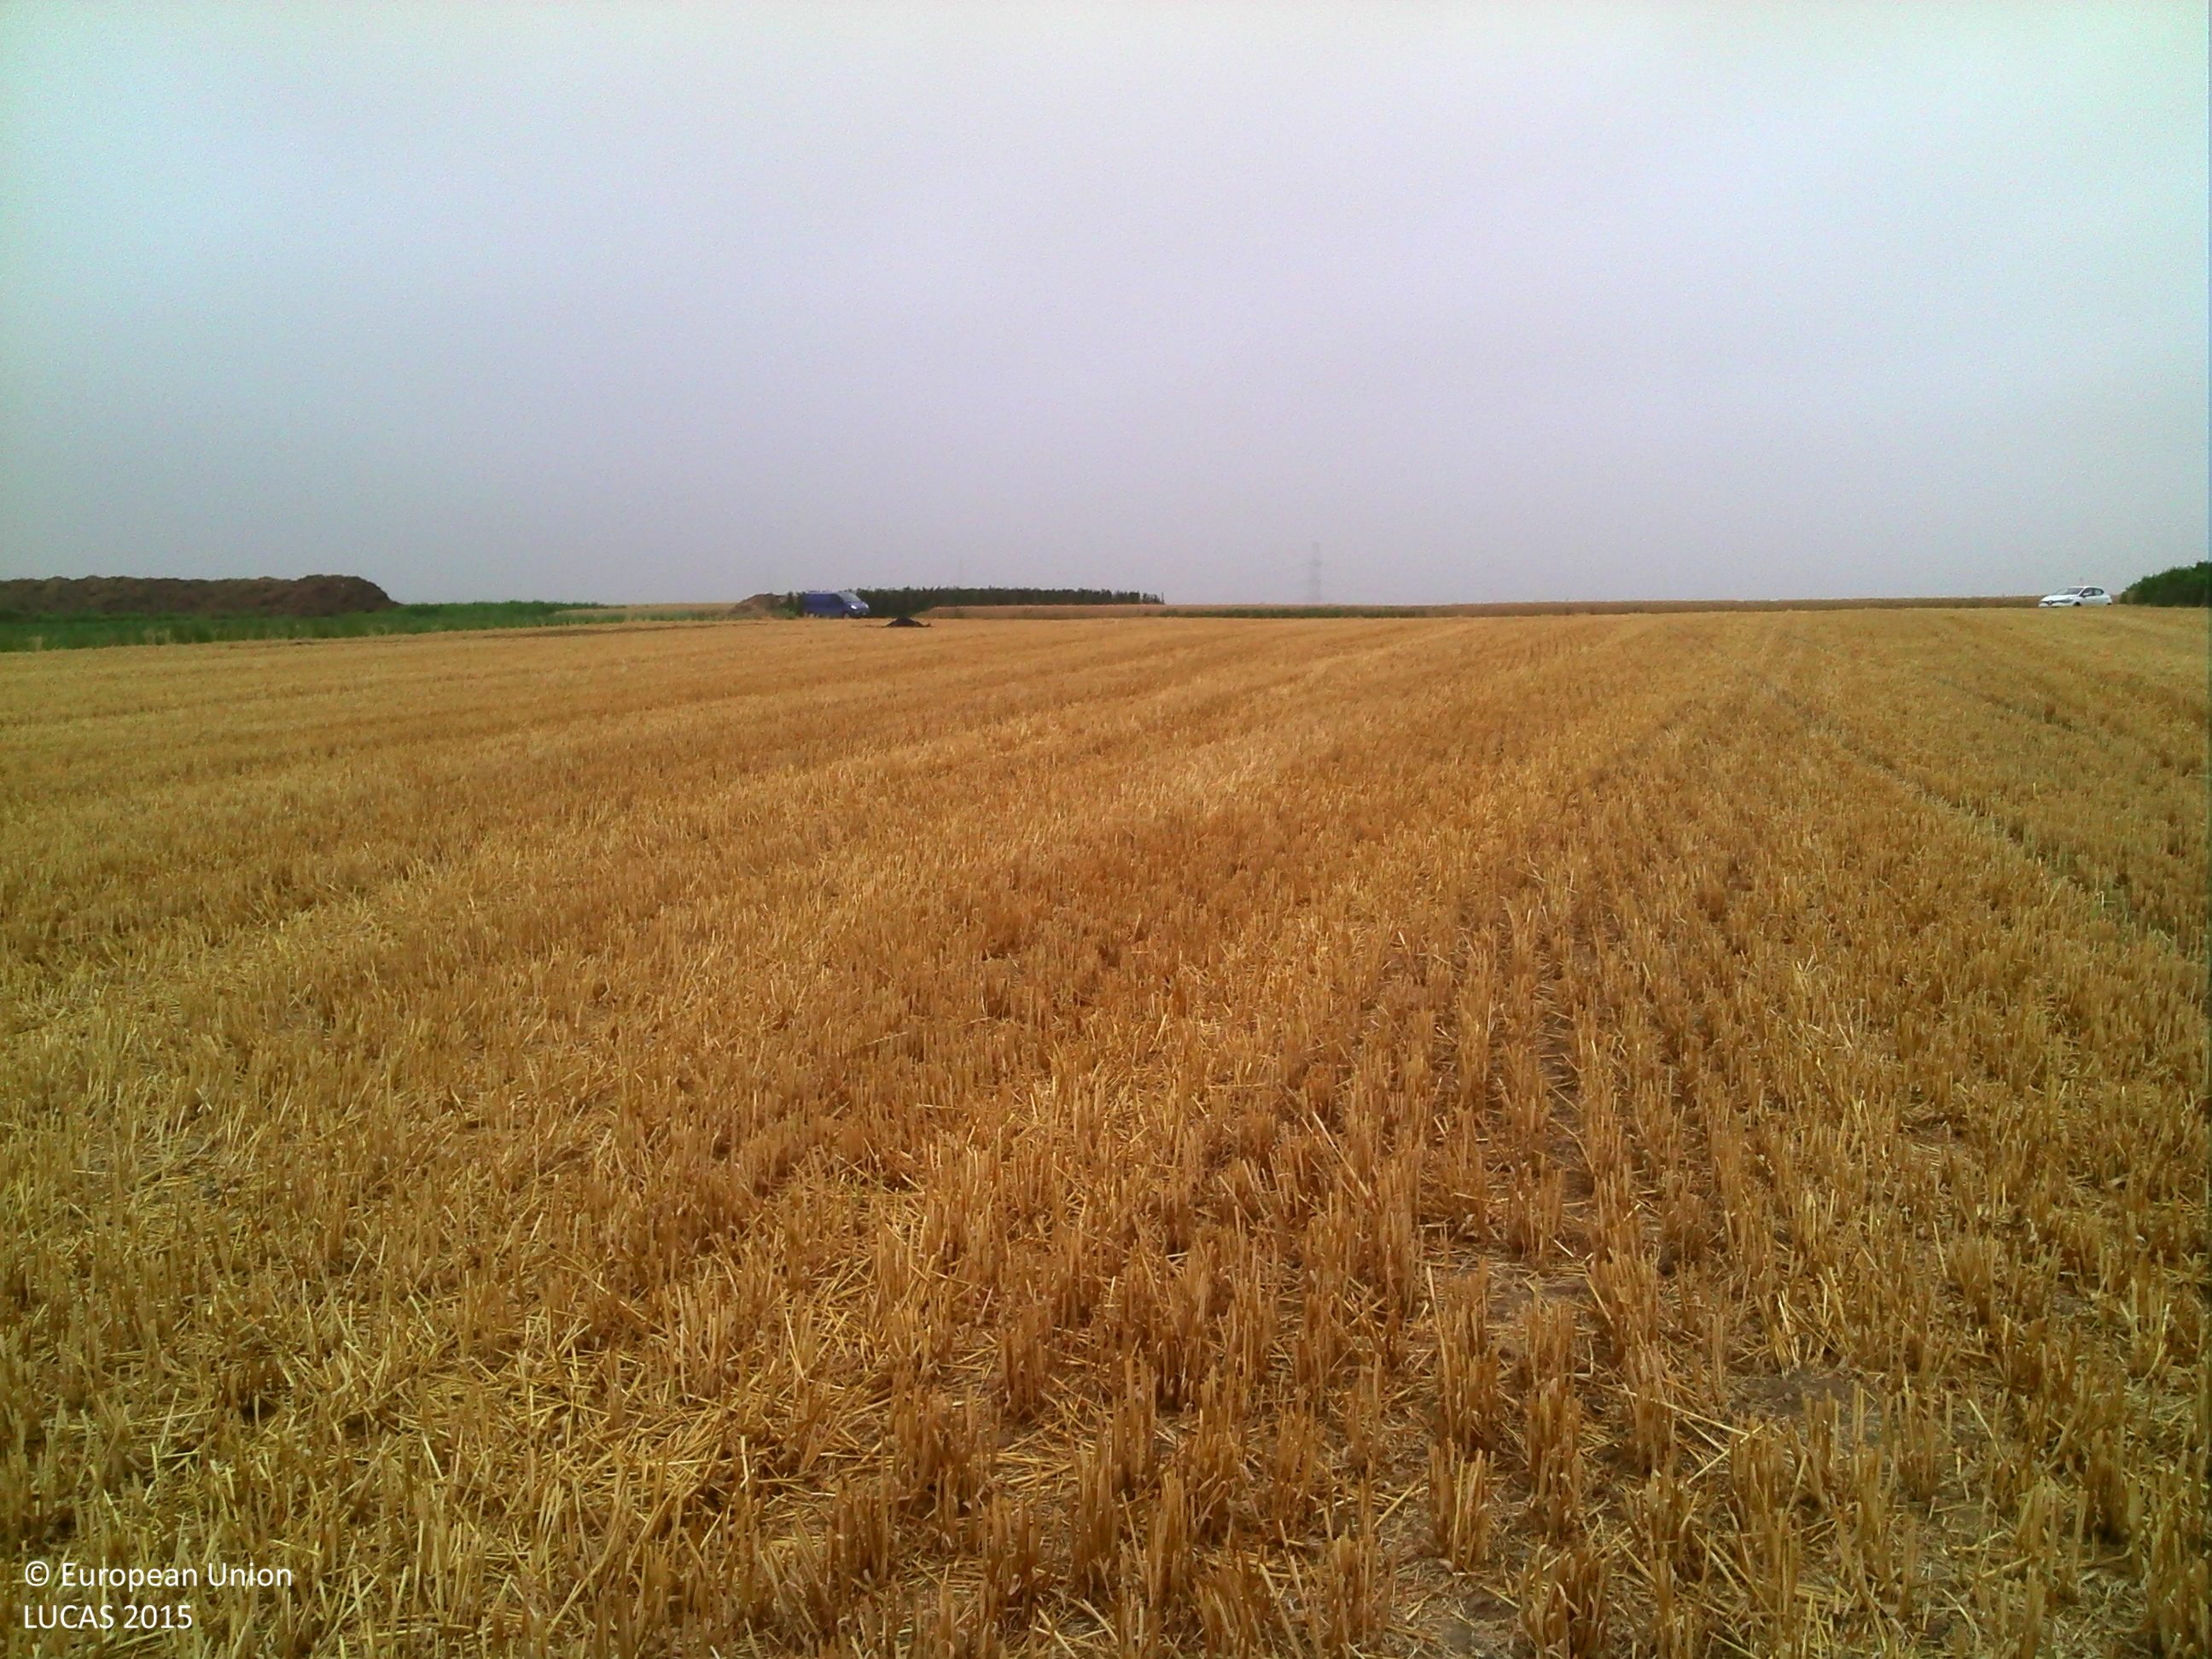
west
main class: Cropland
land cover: Barley
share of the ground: > 75 %
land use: Agriculture (excluding fallow land and kitchen gardens)
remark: Harvested field
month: July
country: BE
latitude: 50.7641
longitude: 5.5606
